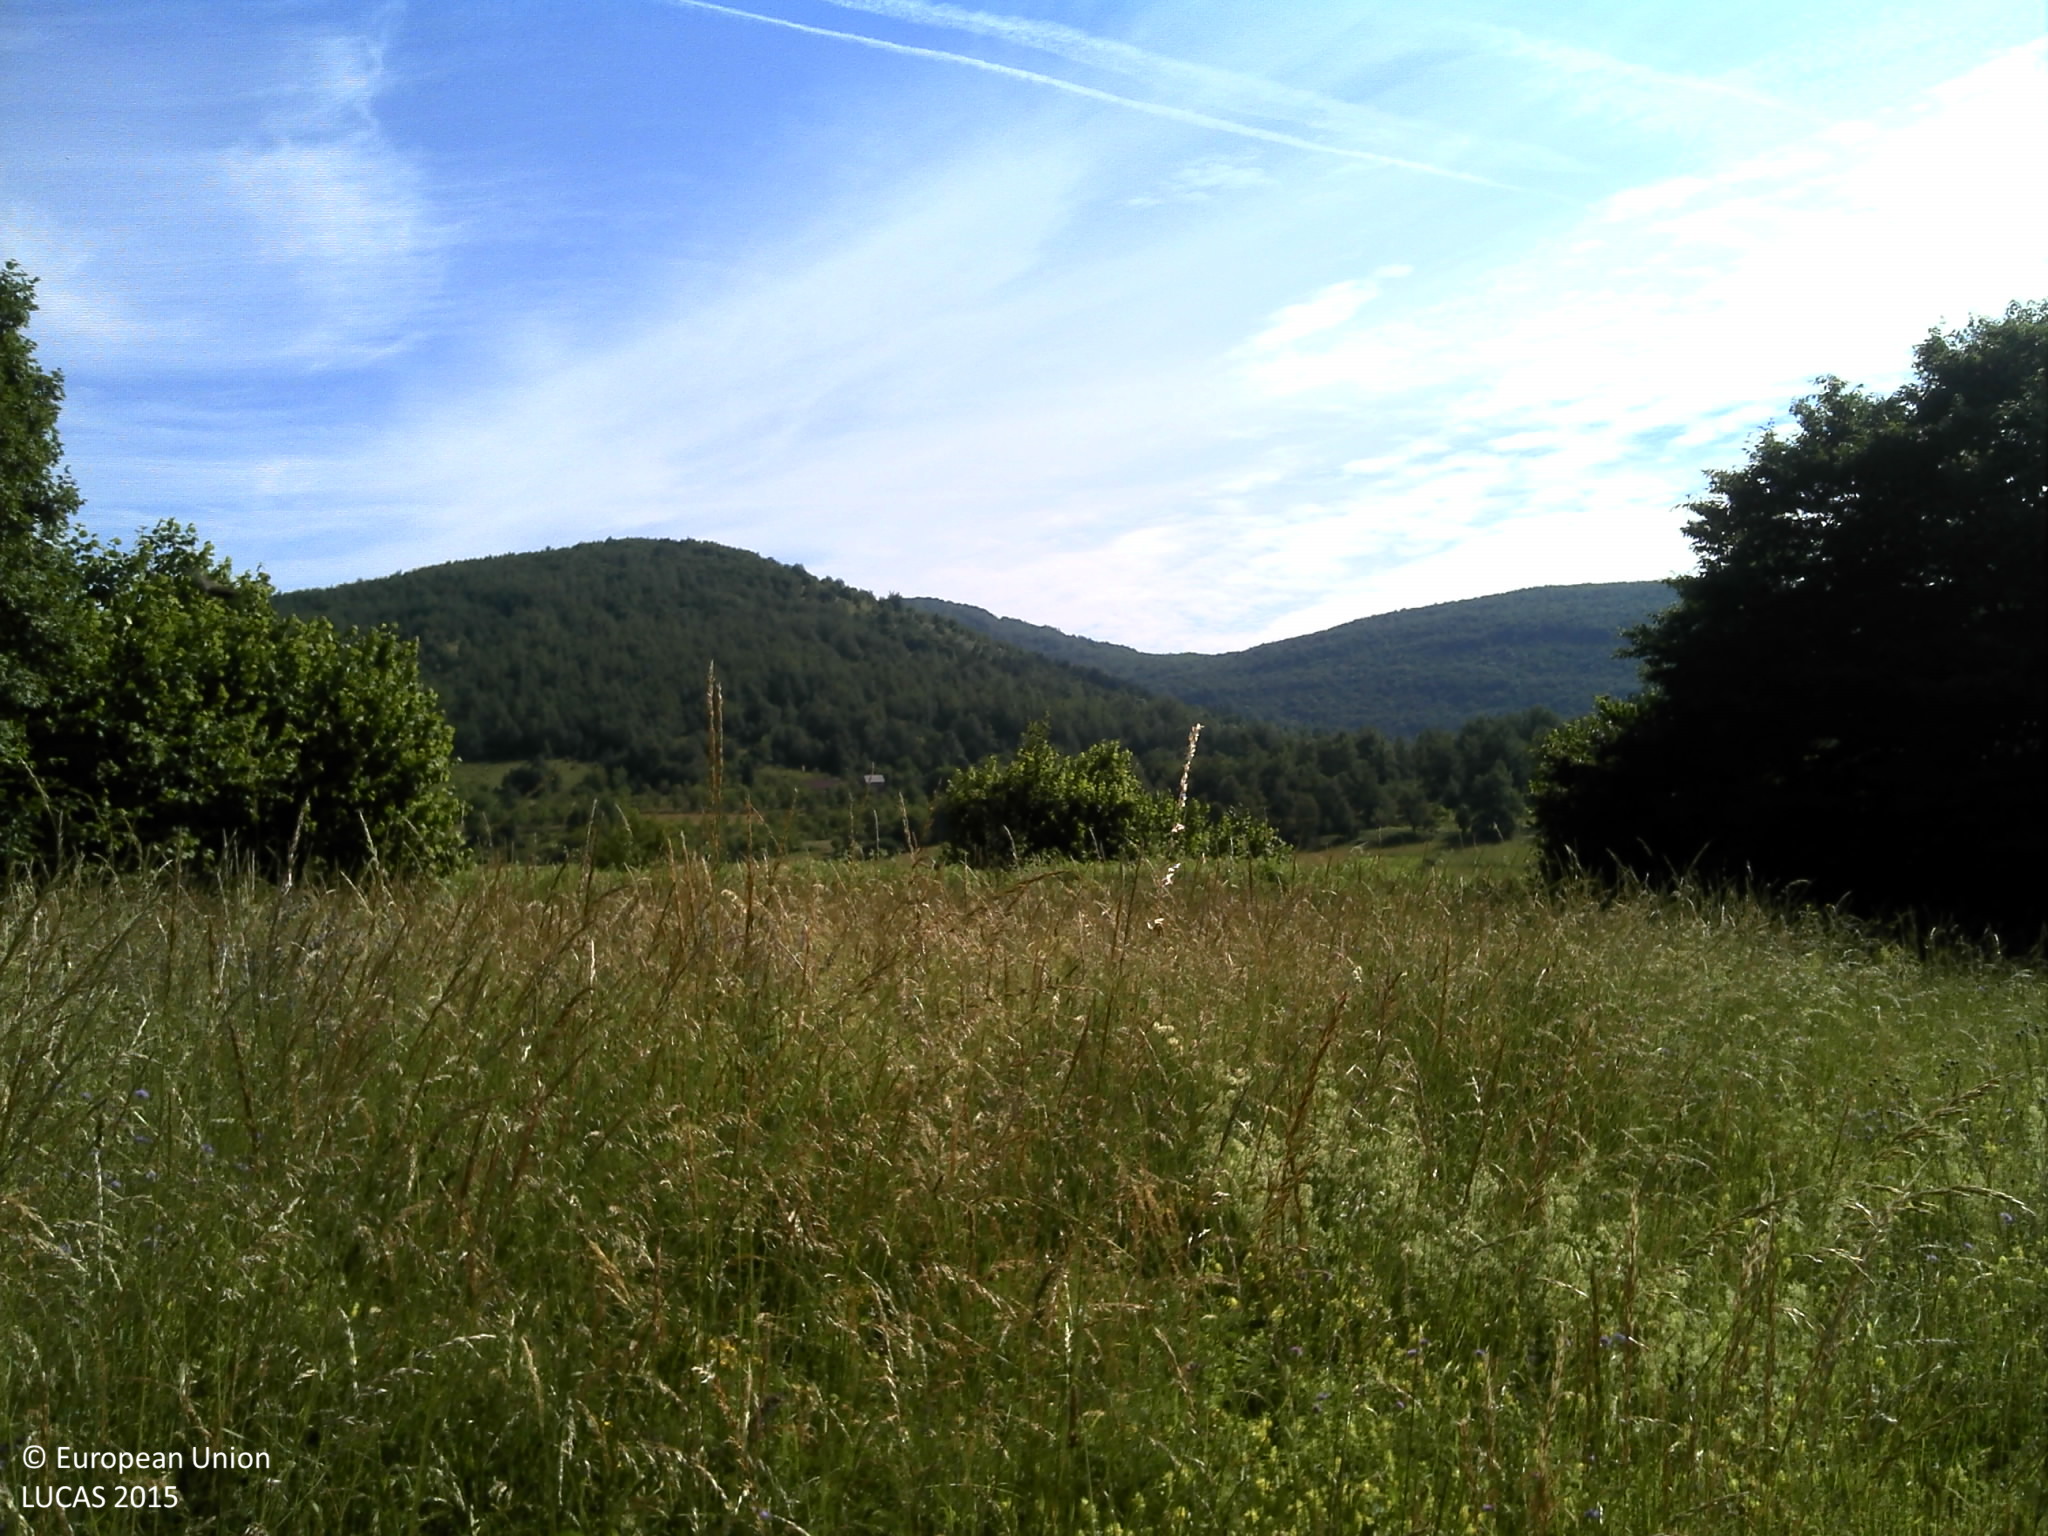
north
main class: Grassland
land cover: Grassland without tree/shrub cover
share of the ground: > 75 %
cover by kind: herbaceous plants 100 %
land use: Semi-natural and natural areas not in use
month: June
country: HR
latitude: 44.5789
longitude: 15.9258
